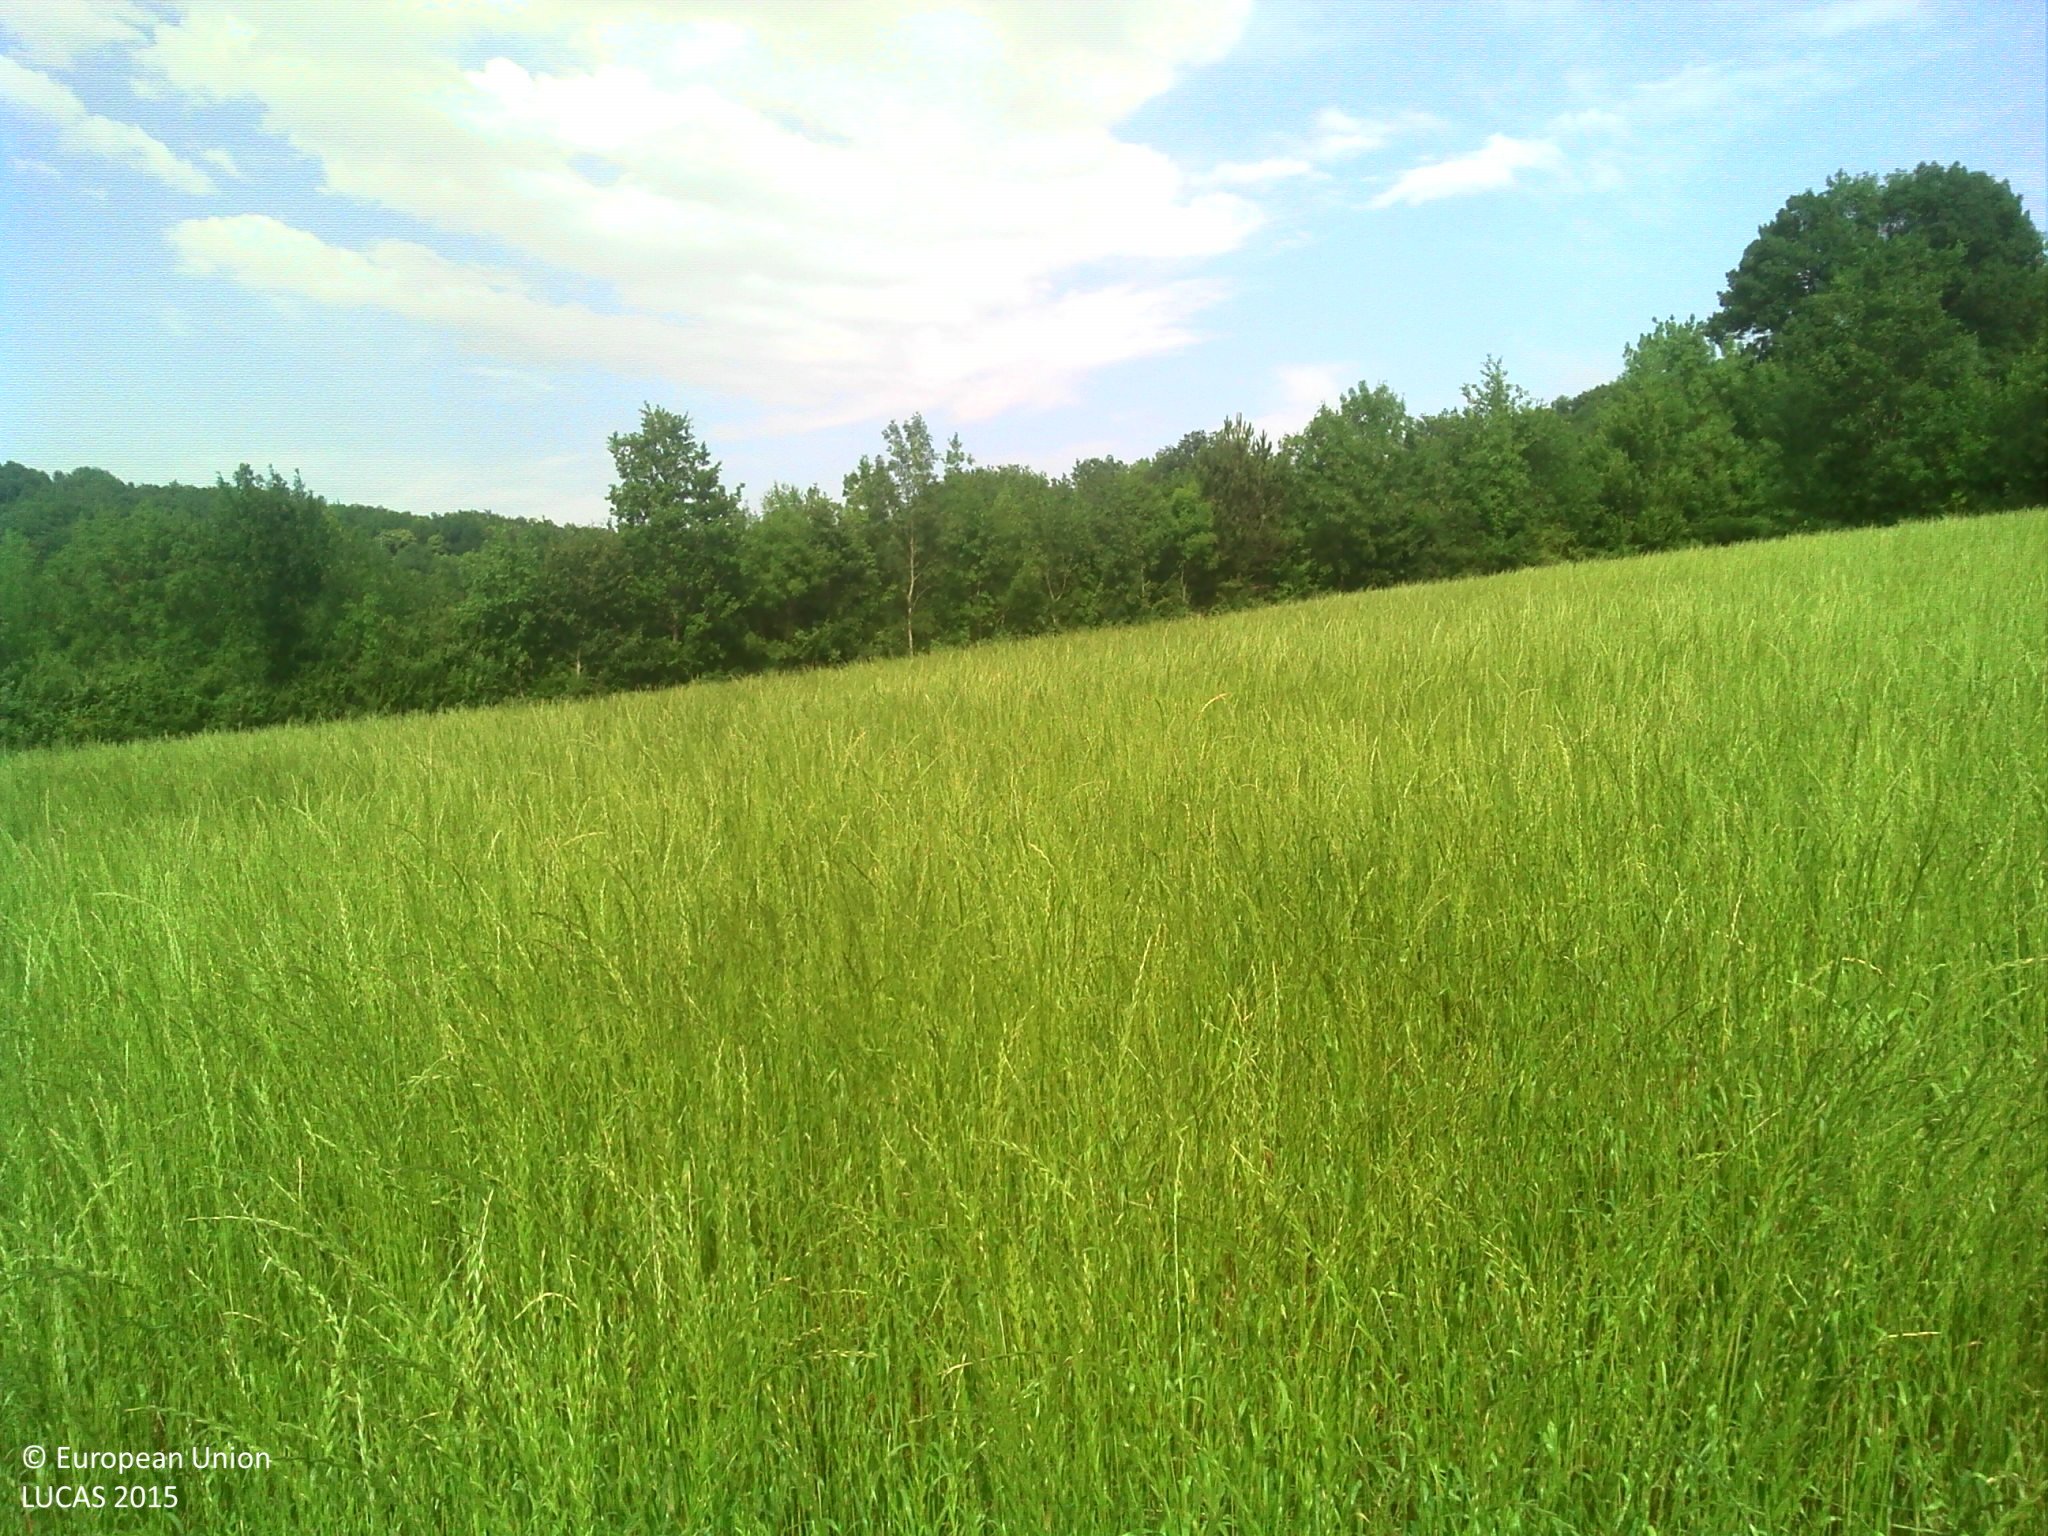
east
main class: Cropland
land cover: Temporary grasslands
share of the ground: > 75 %
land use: Agriculture (excluding fallow land and kitchen gardens)
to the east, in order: Temporary grasslands; Fences; Abandoned hedges; Grassland without tree/shrub cover; Abandoned hedges; Grassland without tree/shrub cover; Broadleaved woodland
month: June
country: FR
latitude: 43.6952
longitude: 1.9767
